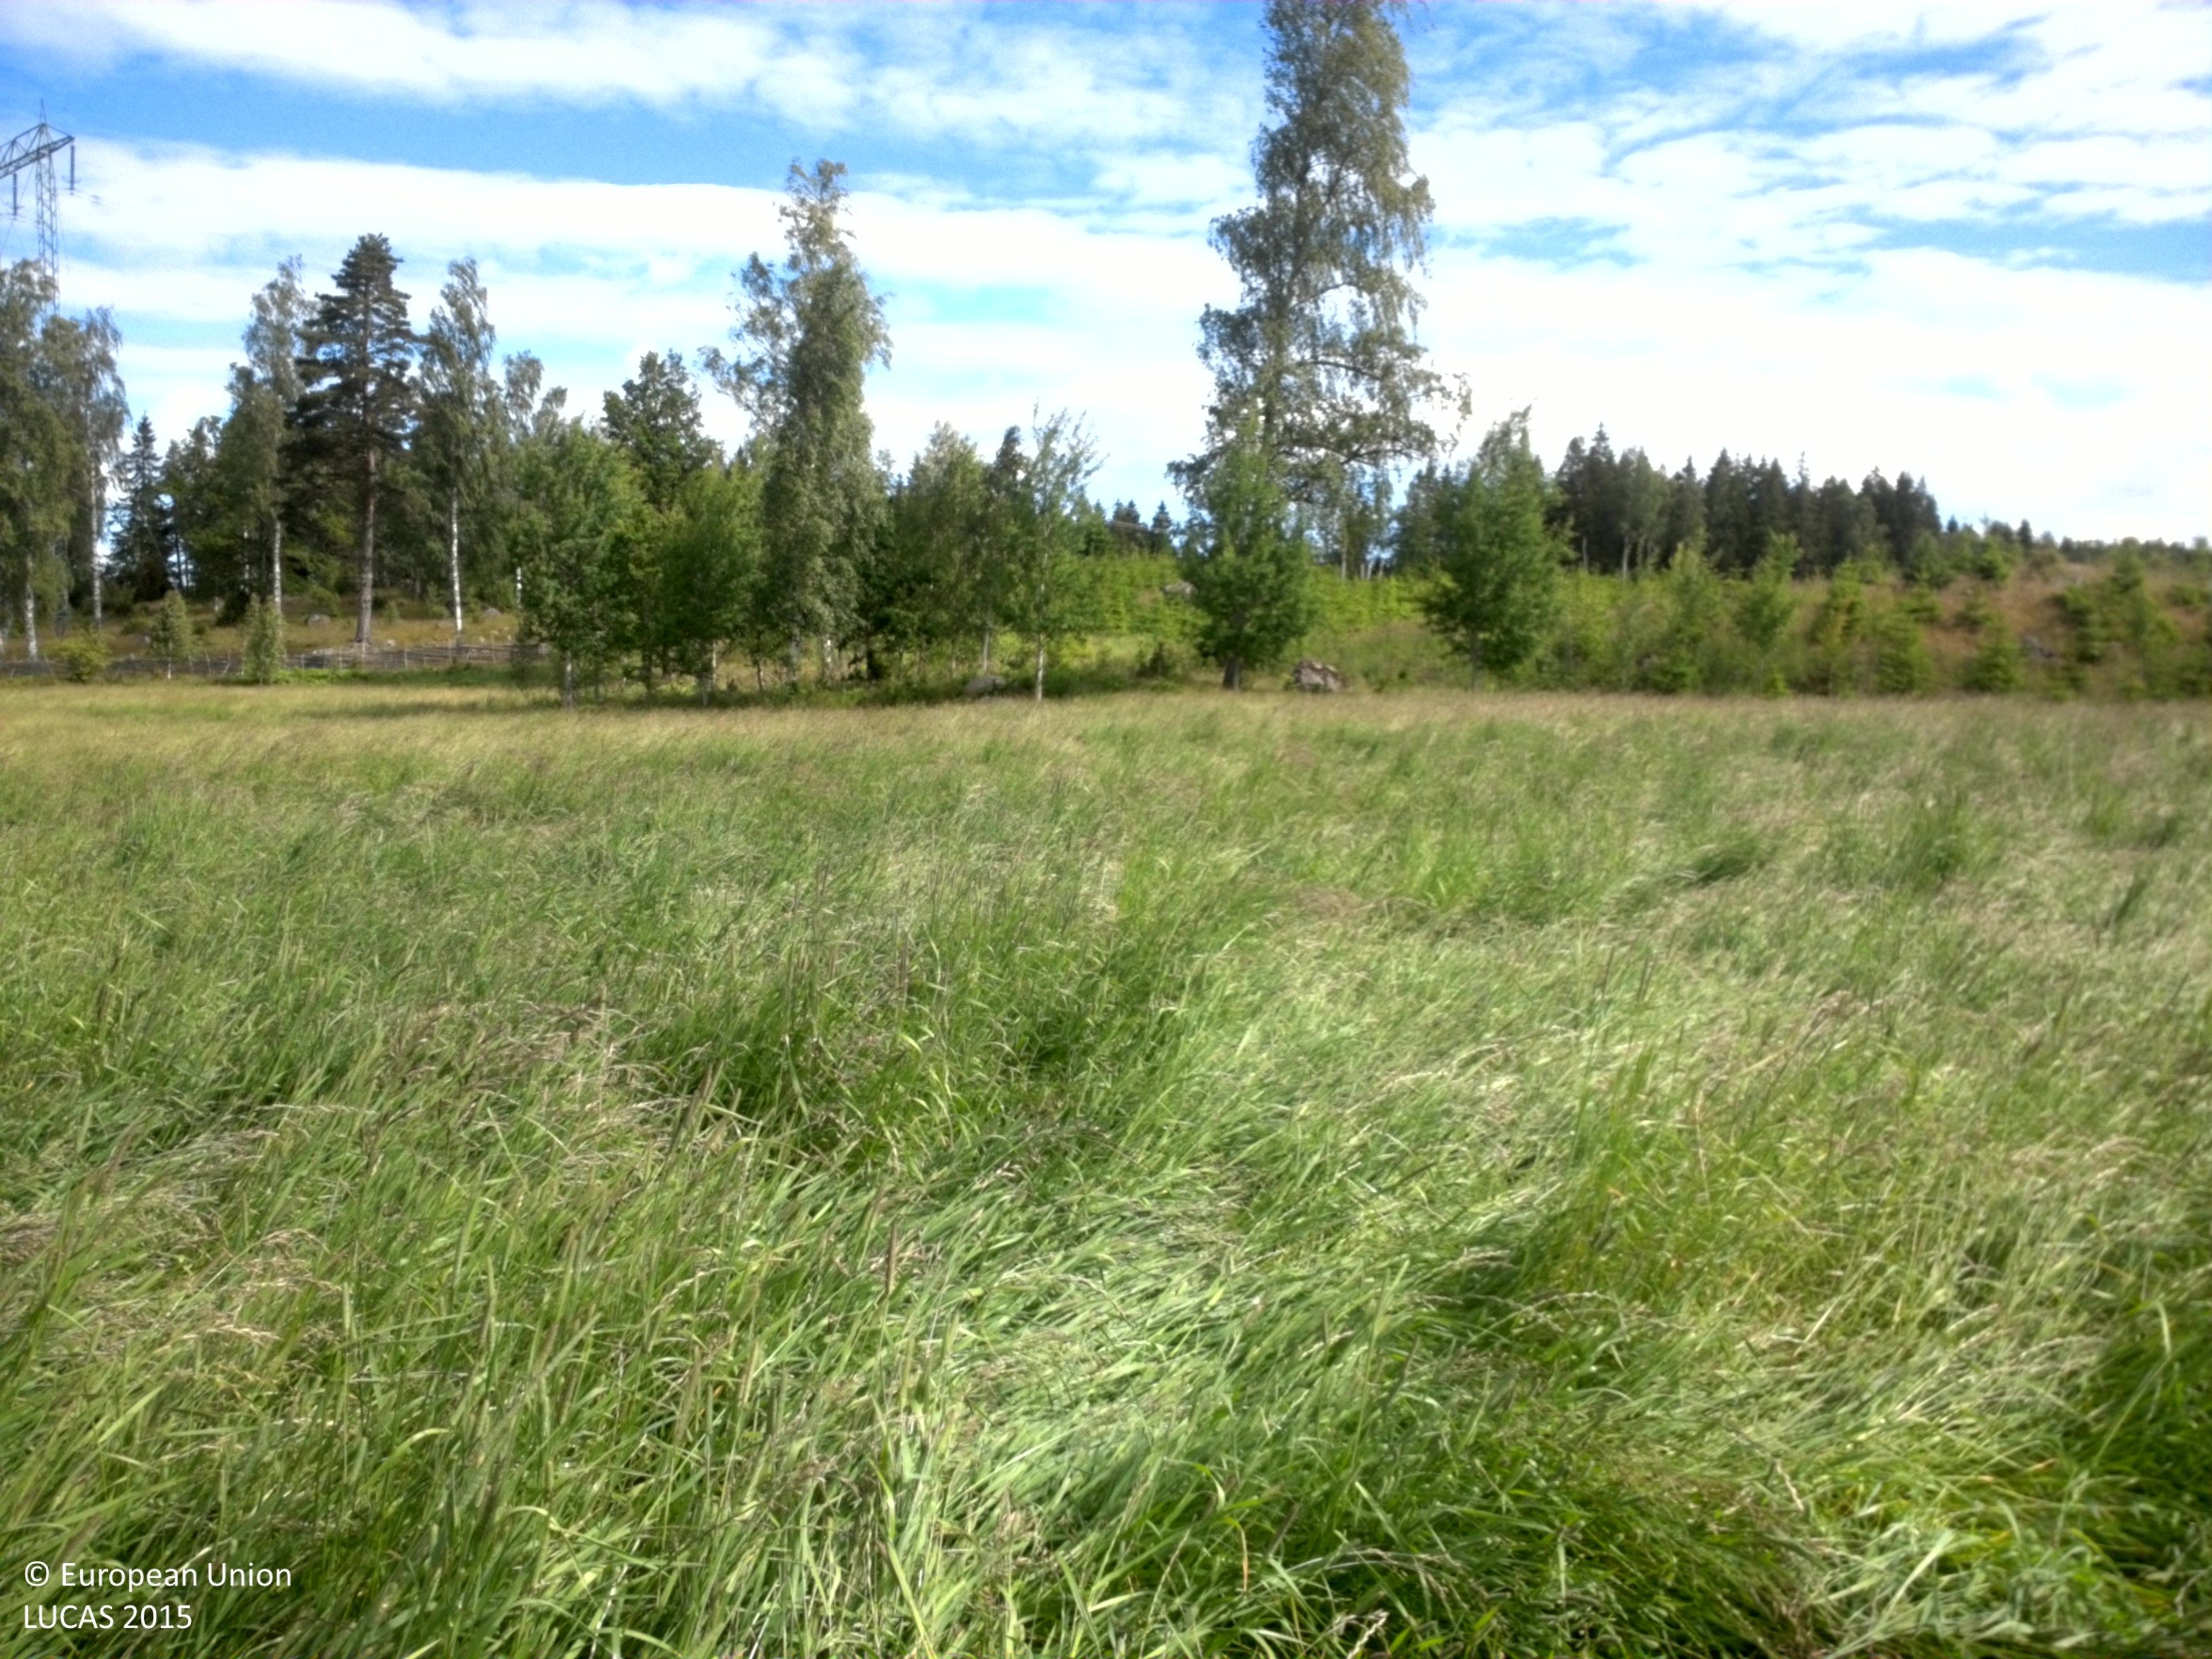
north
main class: Cropland
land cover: Temporary grasslands
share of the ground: > 75 %
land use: Agriculture (excluding fallow land and kitchen gardens)
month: June
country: SE
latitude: 58.5395
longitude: 15.5084
